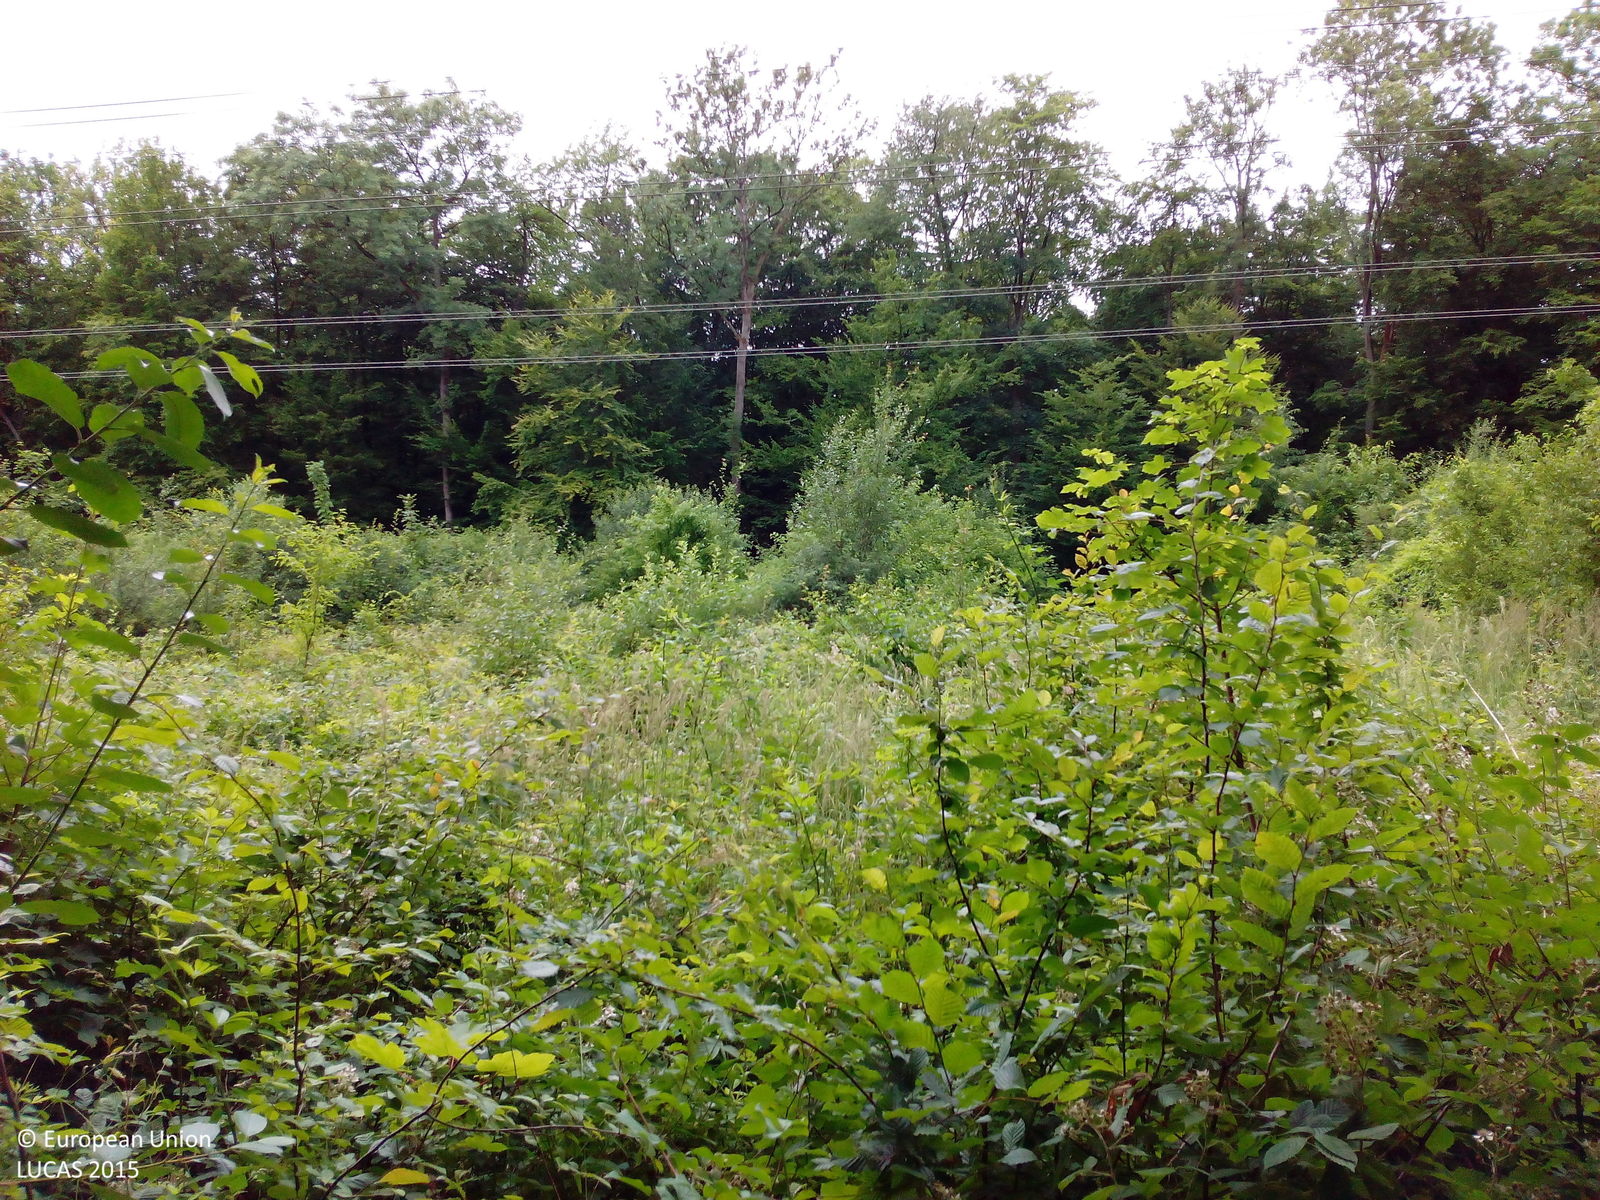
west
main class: Artificial land
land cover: Other artificial areas
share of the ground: > 75 %
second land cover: Shrubland with sparse tree cover
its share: > 75 %
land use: Electricity, gas and thermal power distribution
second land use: Forestry
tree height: > 5 m
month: July
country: DE
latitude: 51.5686
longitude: 9.9567
